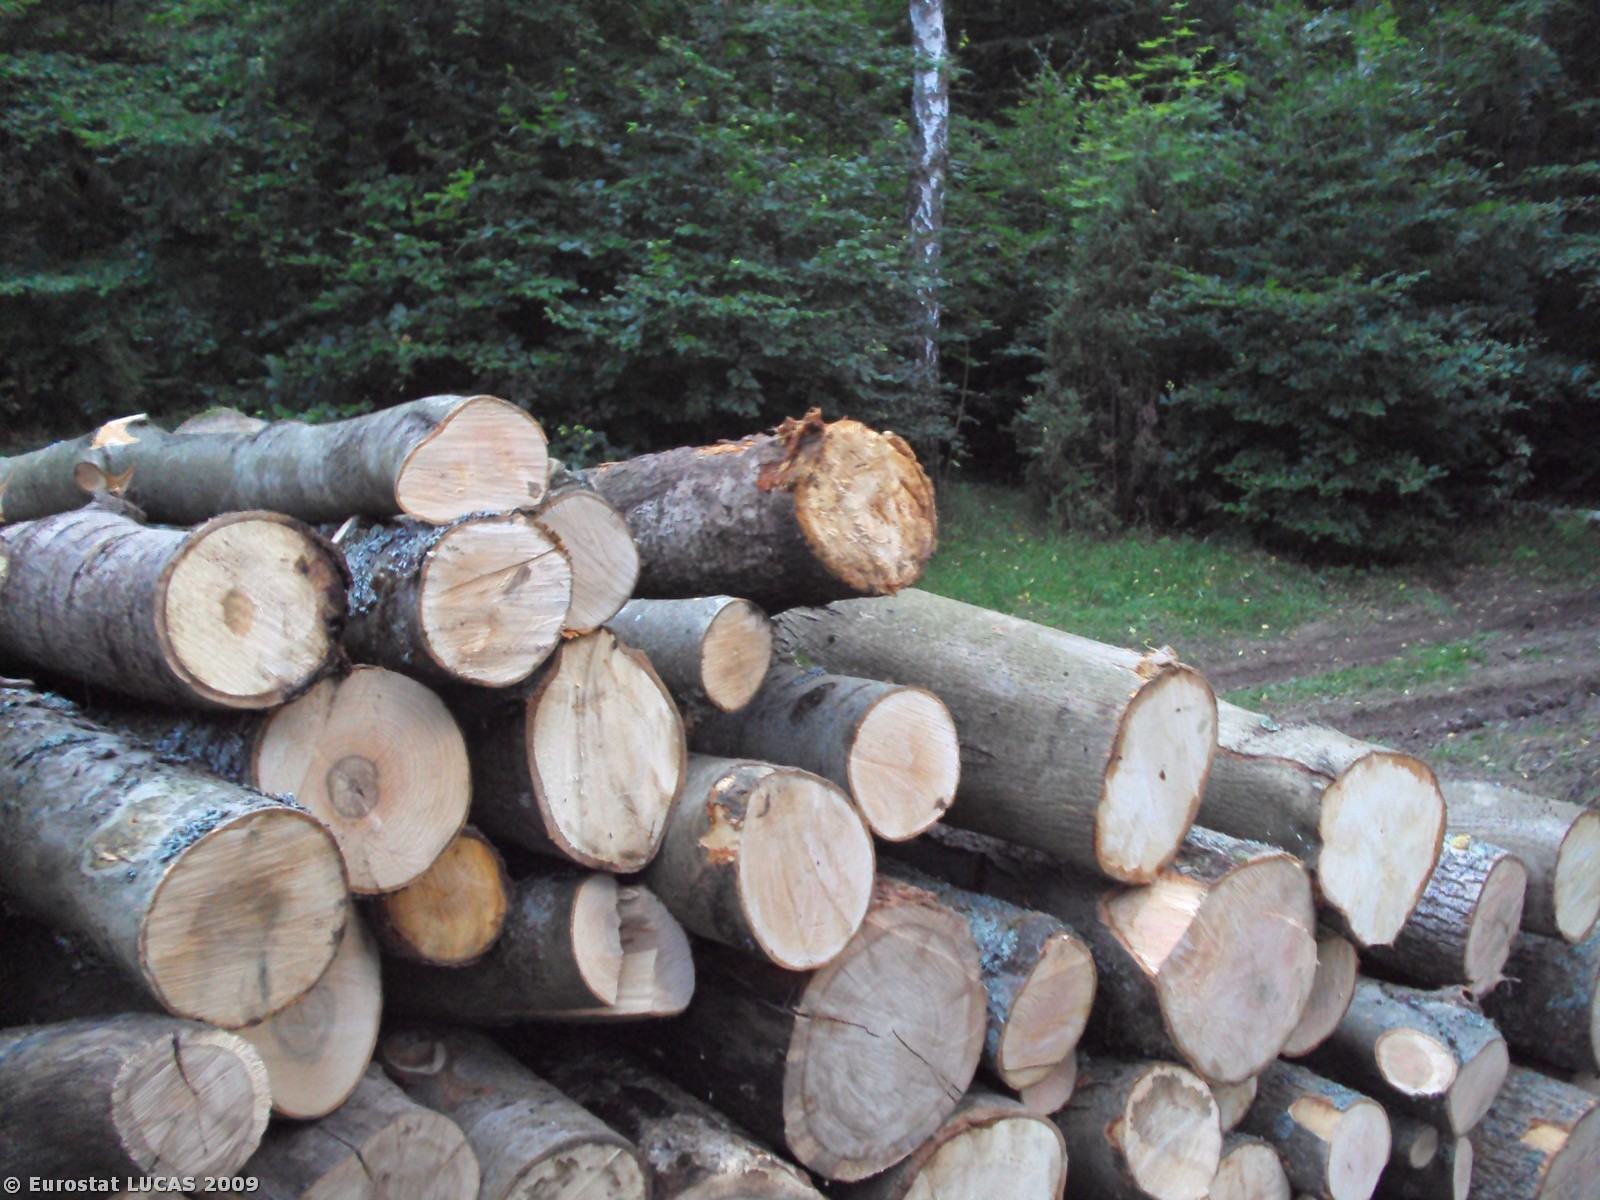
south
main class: Woodland
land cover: Mixed woodland
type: hemiboreal forest and nemoral coniferous forest and mixed broadleaved-coniferous forest
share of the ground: 50 - 75 %
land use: Forestry
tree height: > 5 m
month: August
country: PL
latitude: 53.3270
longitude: 15.9656
